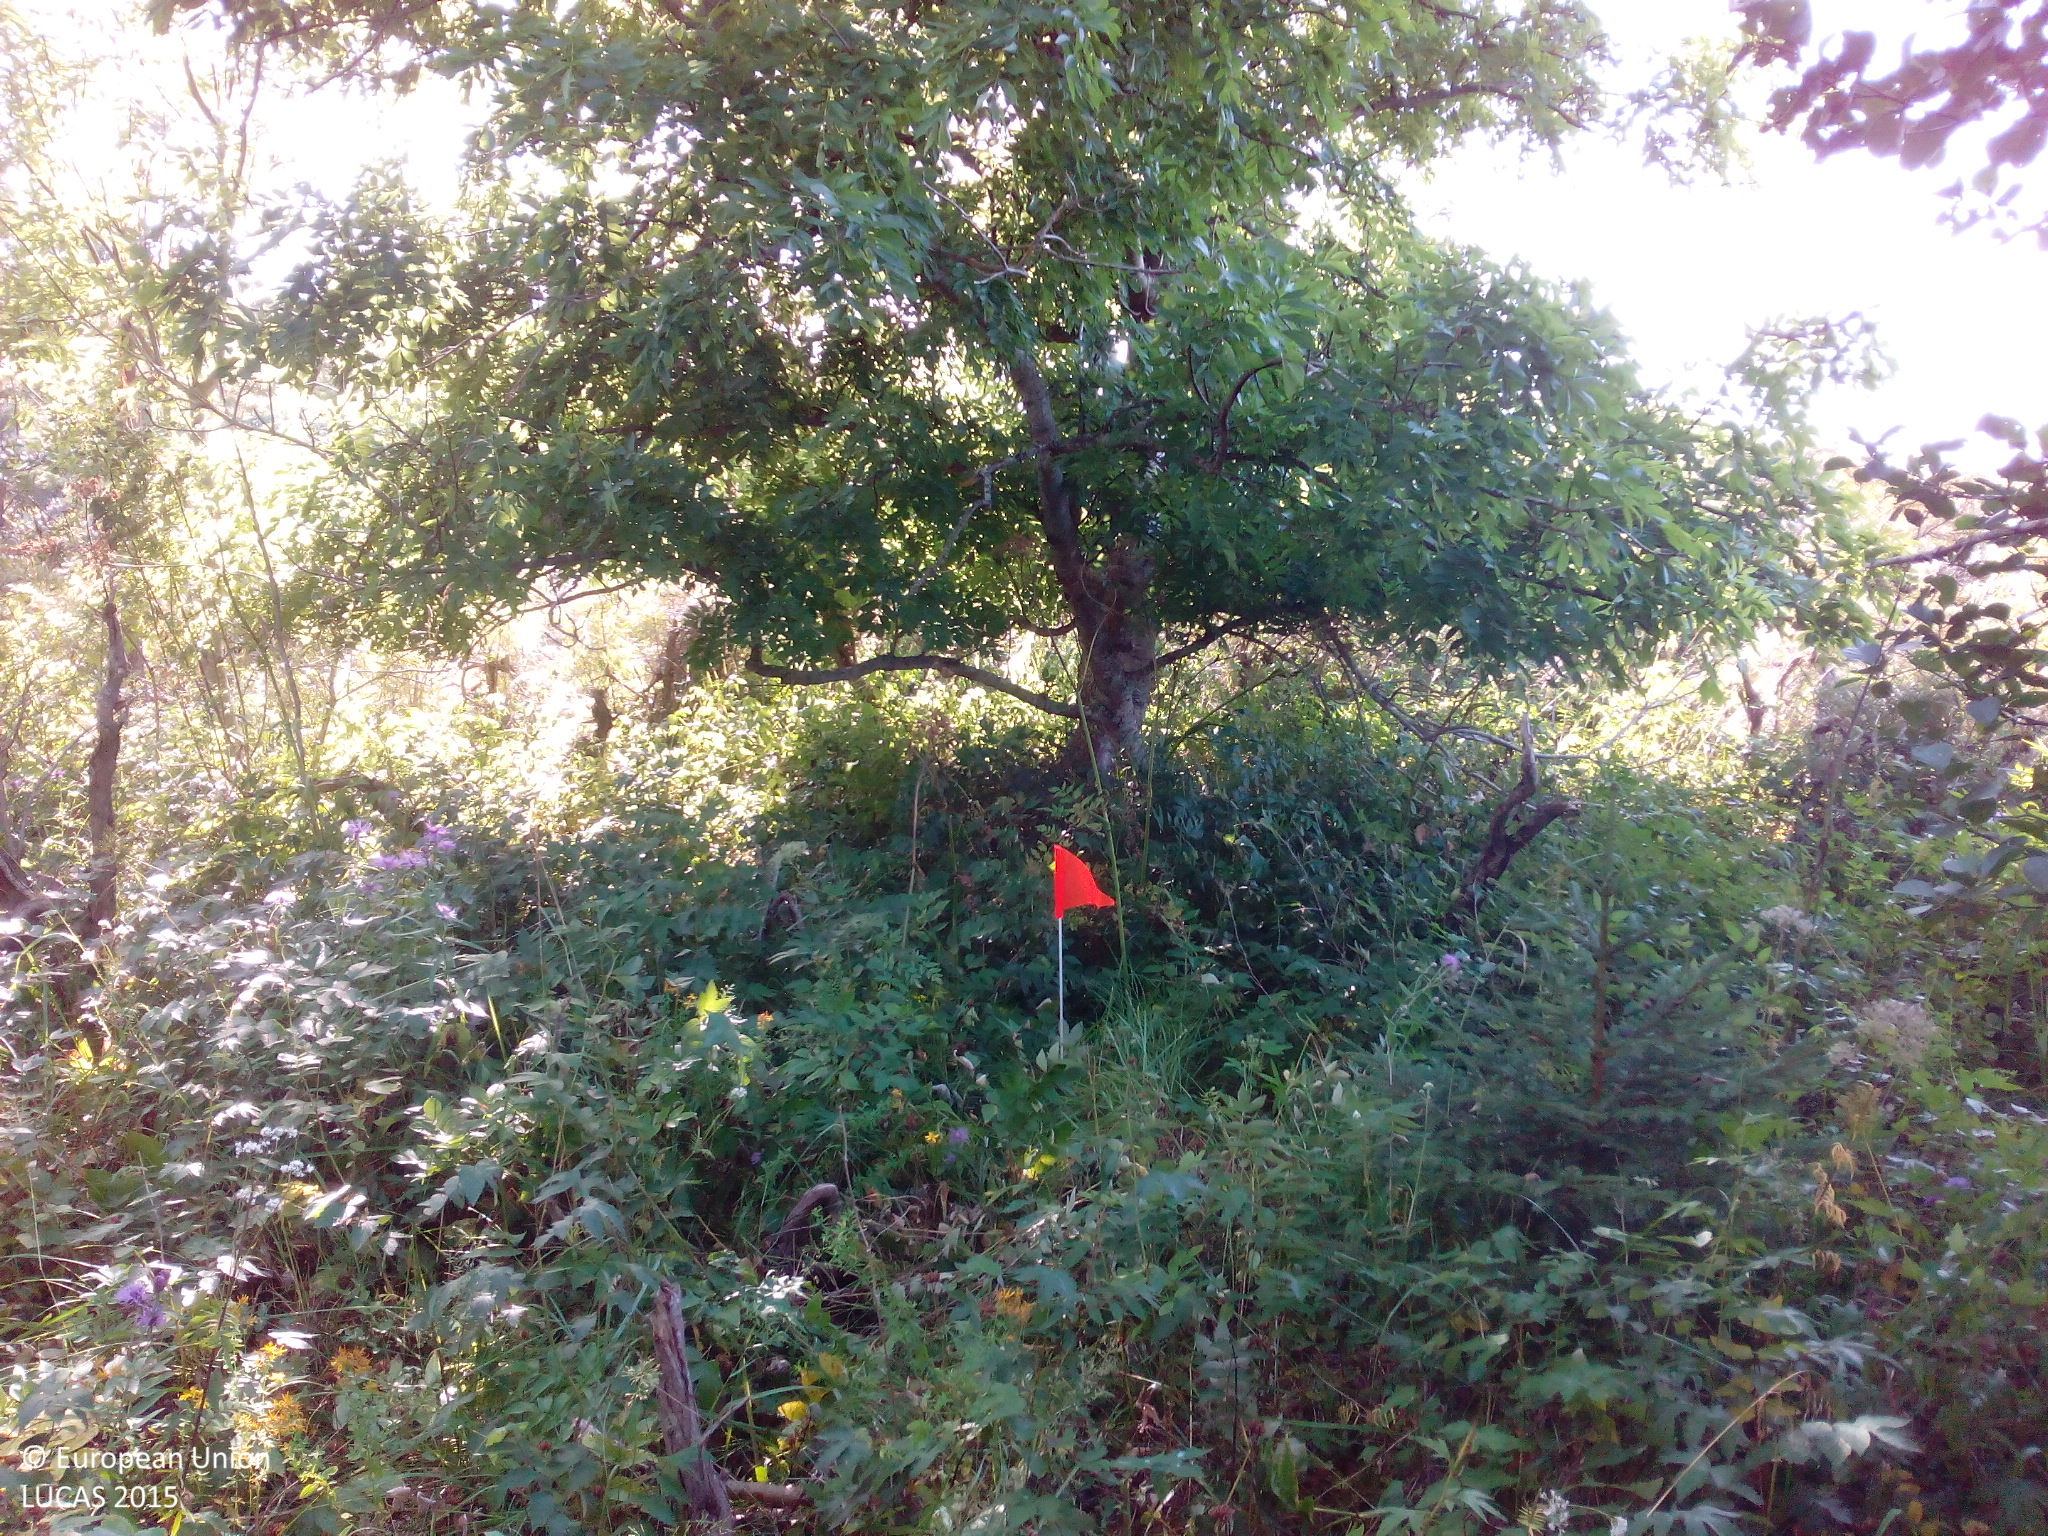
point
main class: Woodland
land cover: Broadleaved woodland
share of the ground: > 75 %
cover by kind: broadleaved forest trees 70 %, herbaceous plants 20 %, coniferous forest trees 10 %
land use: Semi-natural and natural areas not in use
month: August
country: FI
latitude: 60.2983
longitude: 19.7201
